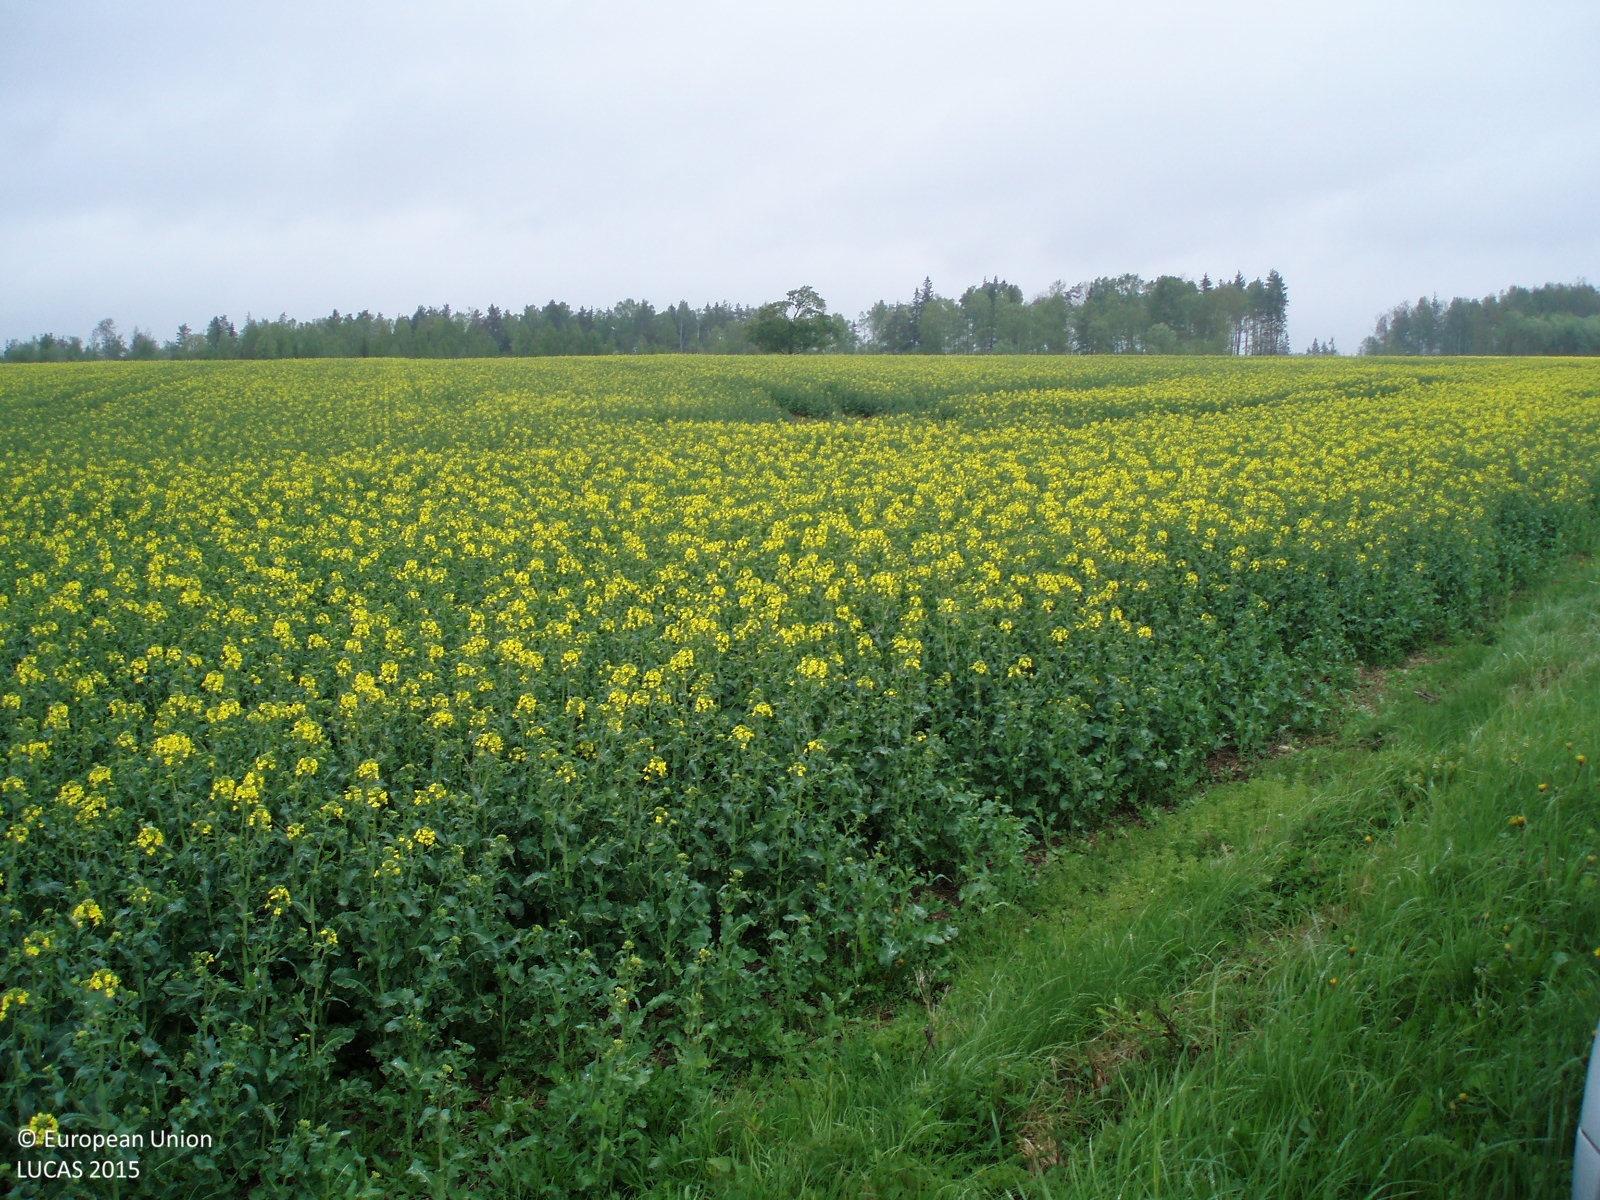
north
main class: Cropland
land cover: Rape and turnip rape
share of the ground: > 75 %
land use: Agriculture (excluding fallow land and kitchen gardens)
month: May
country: LT
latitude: 56.3507
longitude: 22.9297
